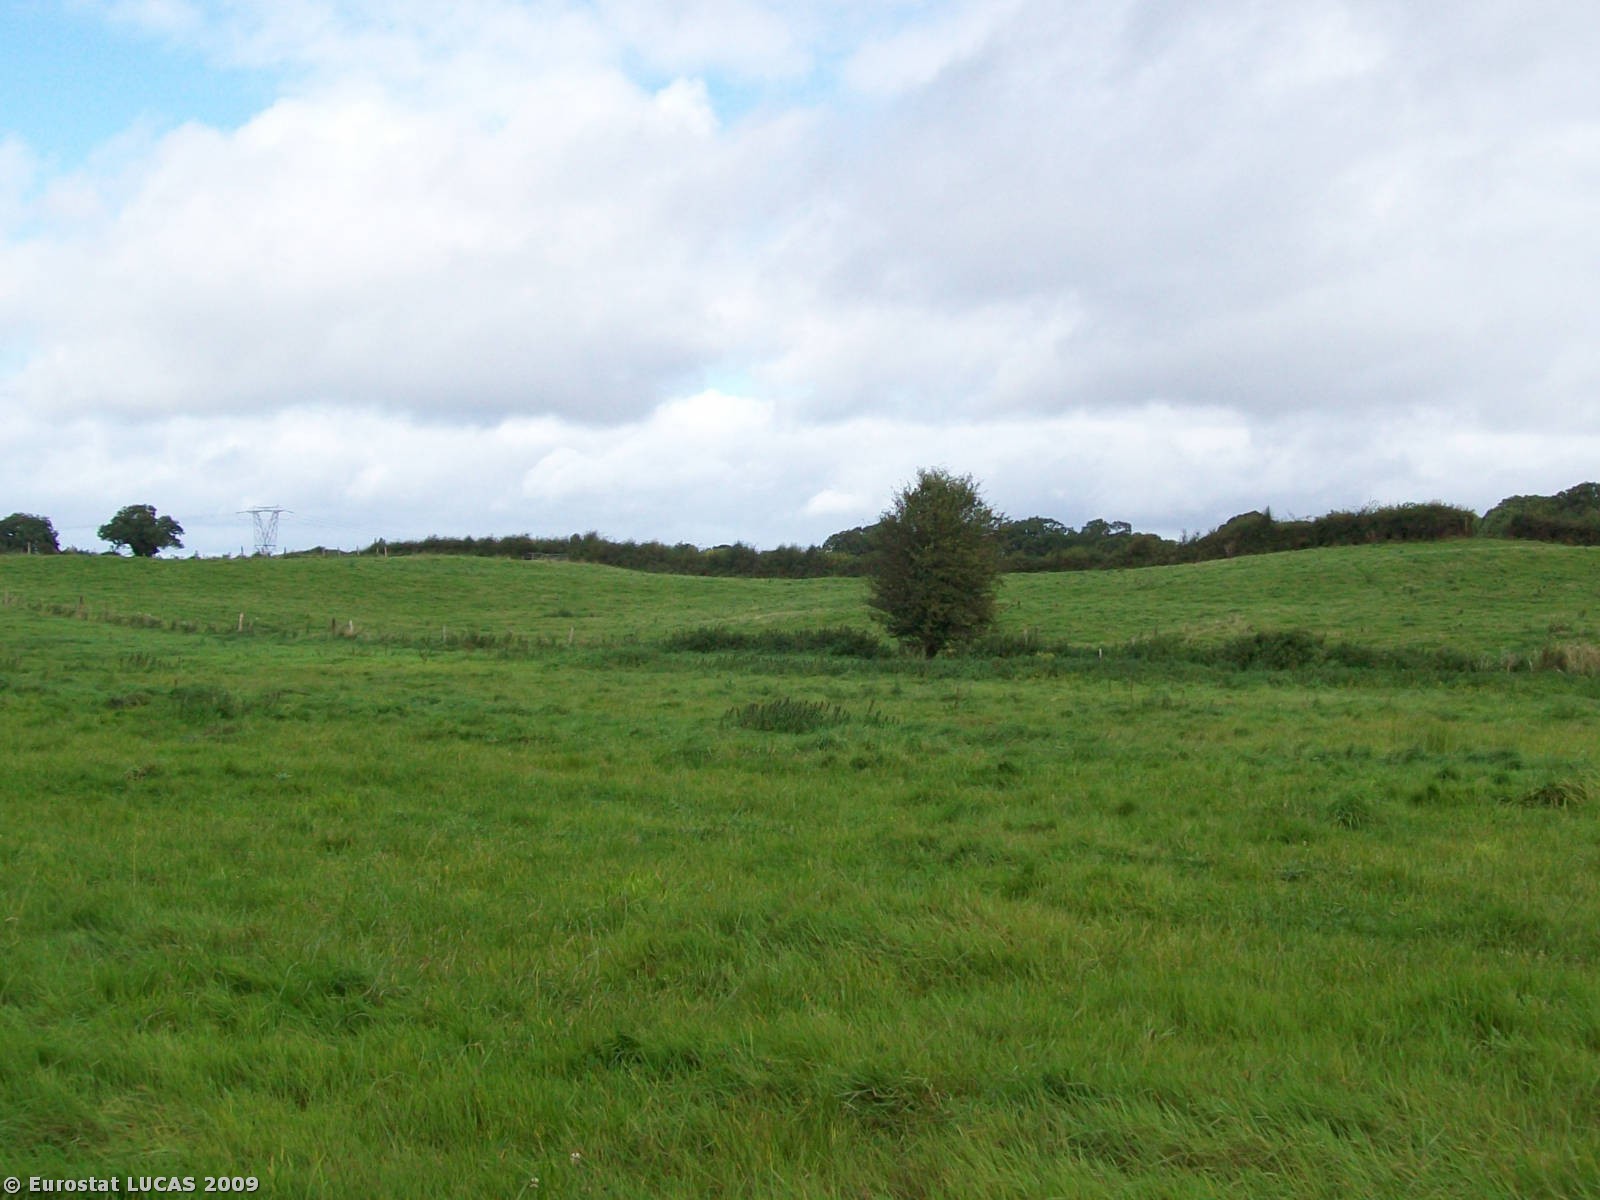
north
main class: Woodland
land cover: Coniferous woodland
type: plantations and self-sown exotic forest
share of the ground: > 75 %
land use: Forestry
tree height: > 5 m
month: September
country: IE
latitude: 53.1507
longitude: -7.9527
